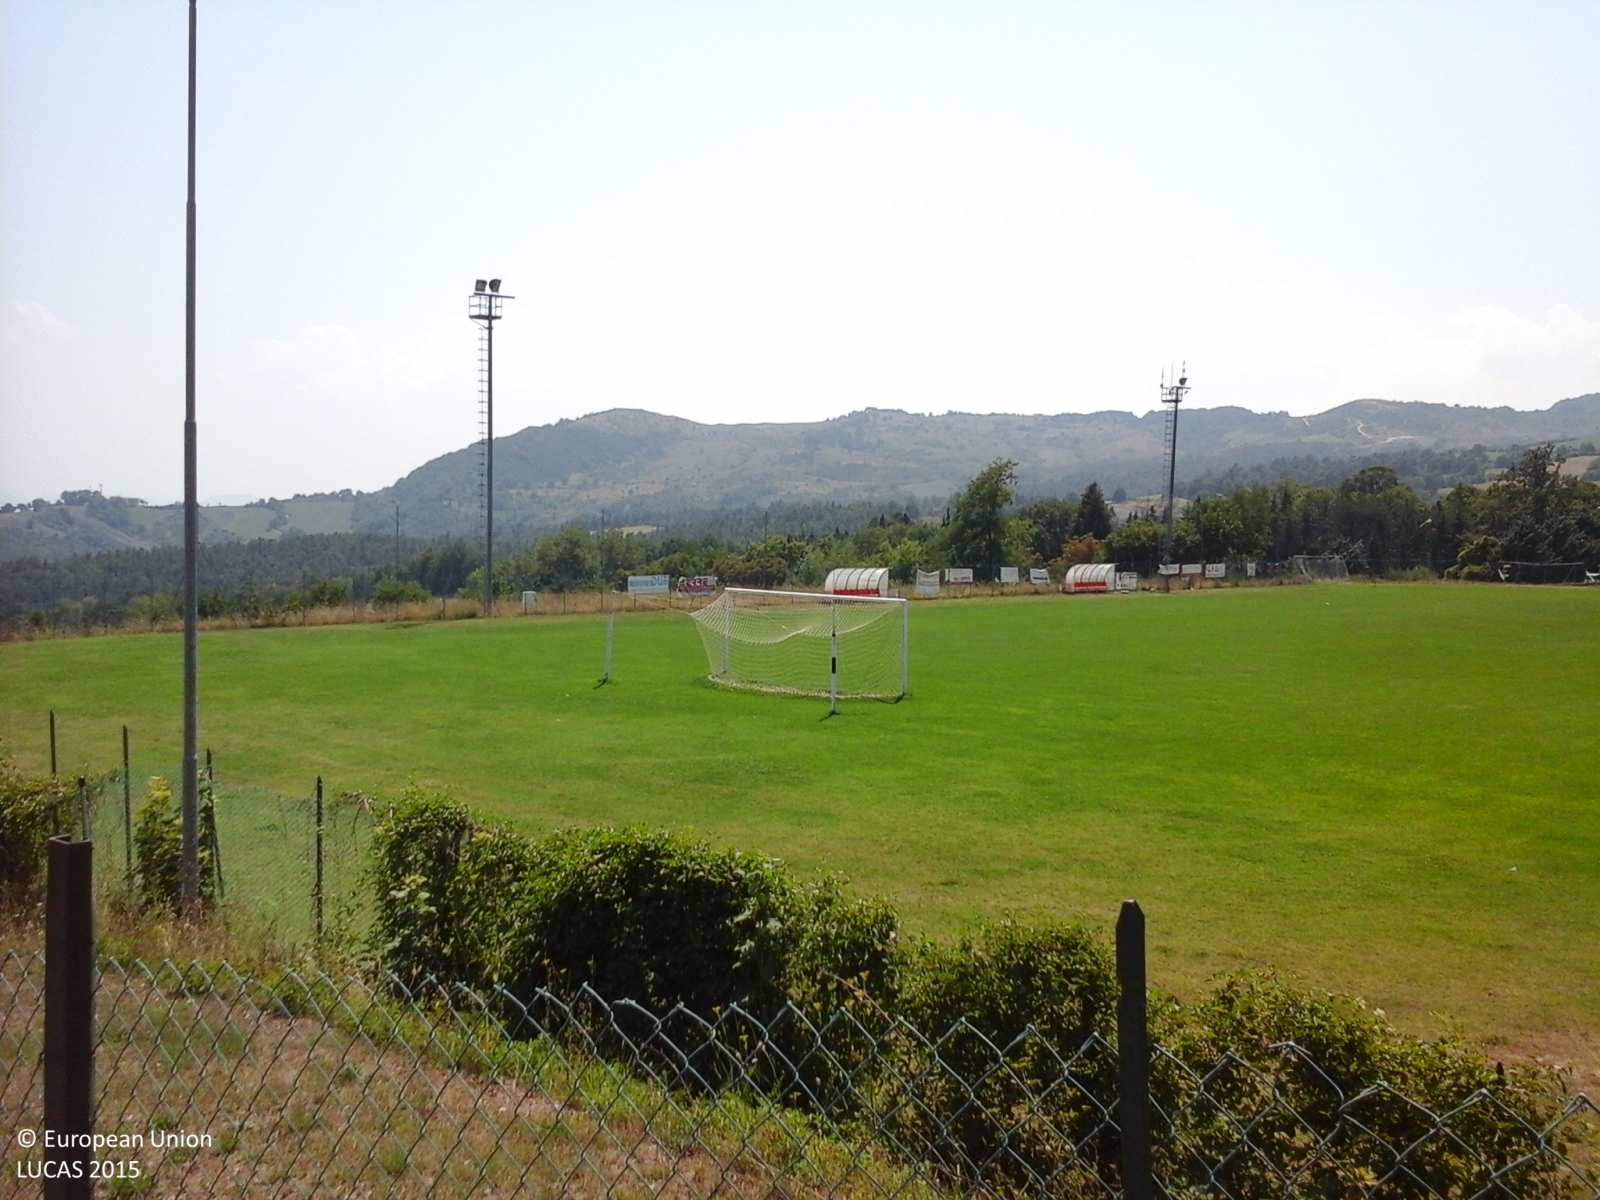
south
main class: Grassland
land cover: Grassland without tree/shrub cover
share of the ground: > 75 %
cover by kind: herbaceous plants 100 %
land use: Residential
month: August
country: IT
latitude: 43.7827
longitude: 12.3426
